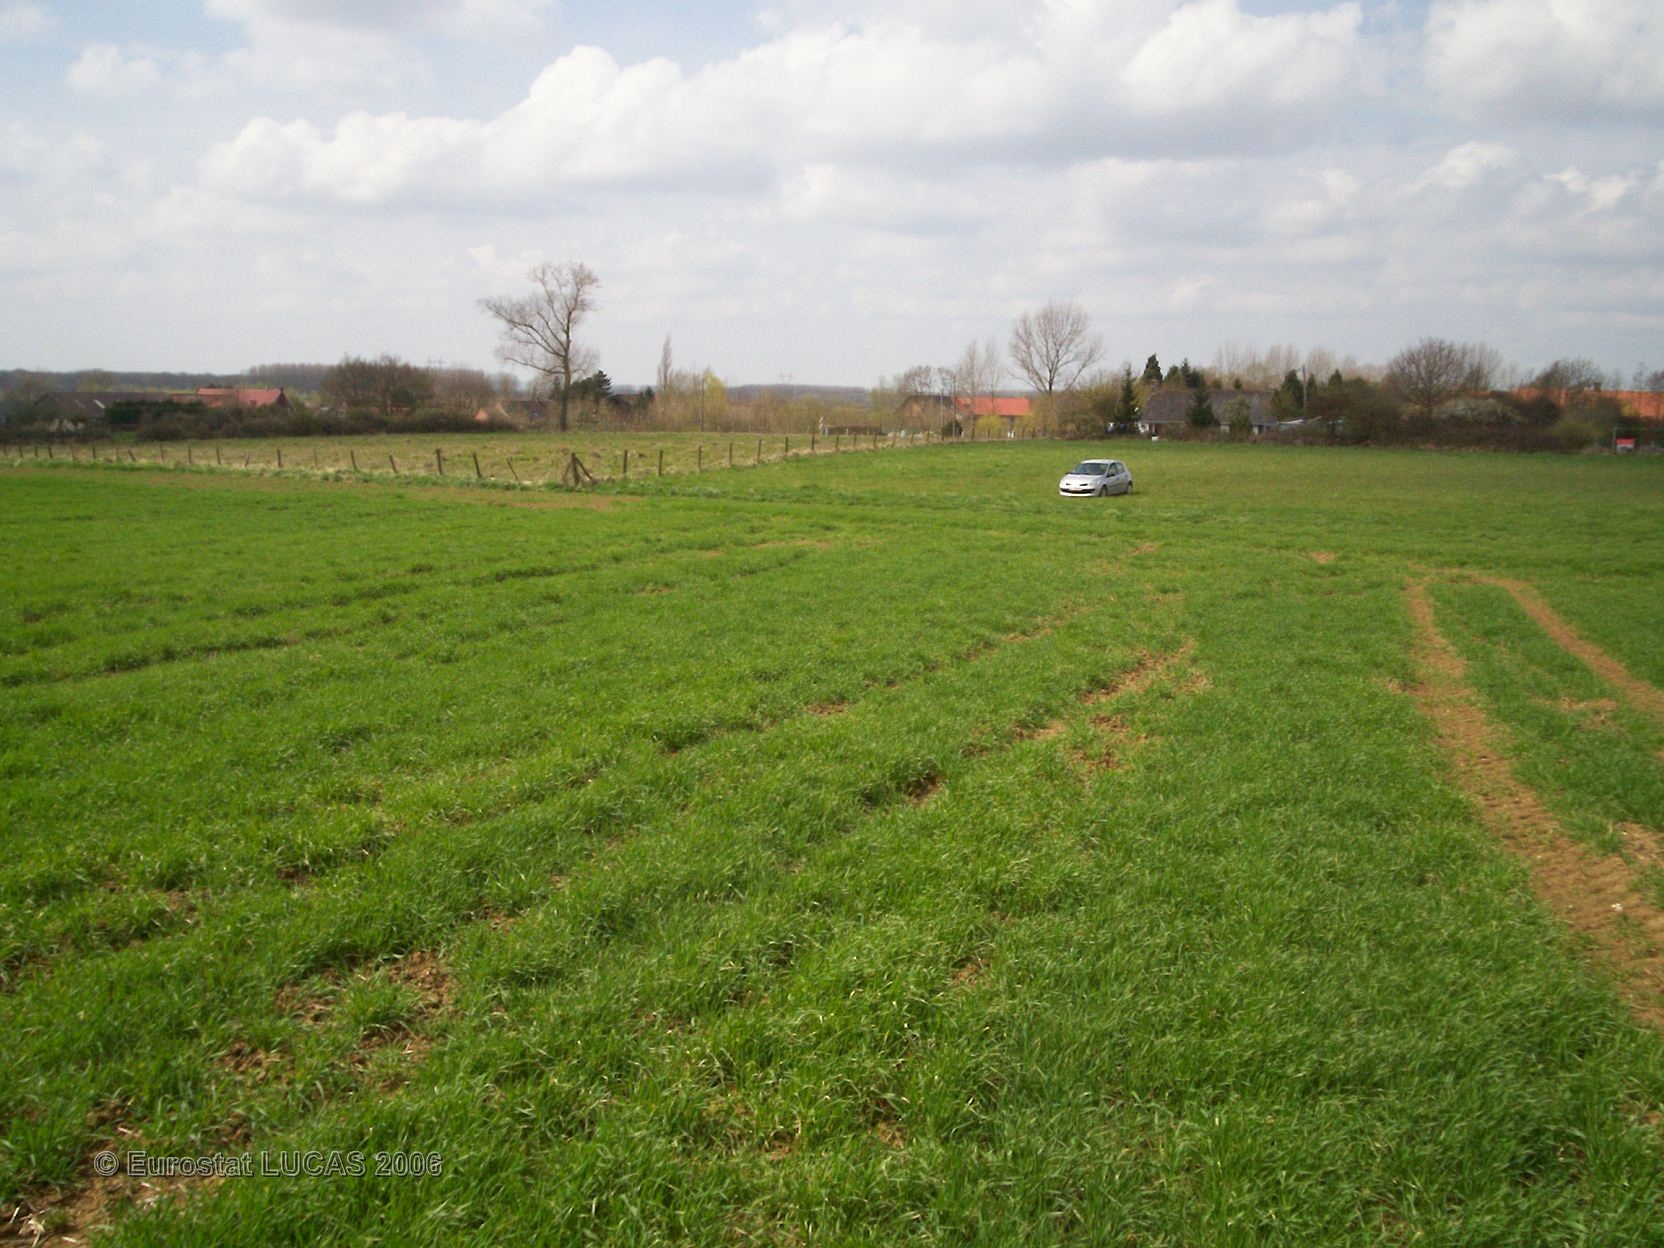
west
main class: Cropland
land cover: Barley
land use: Agriculture (excluding fallow land and kitchen gardens)
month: April
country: FR
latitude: 50.7774
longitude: 2.3709
